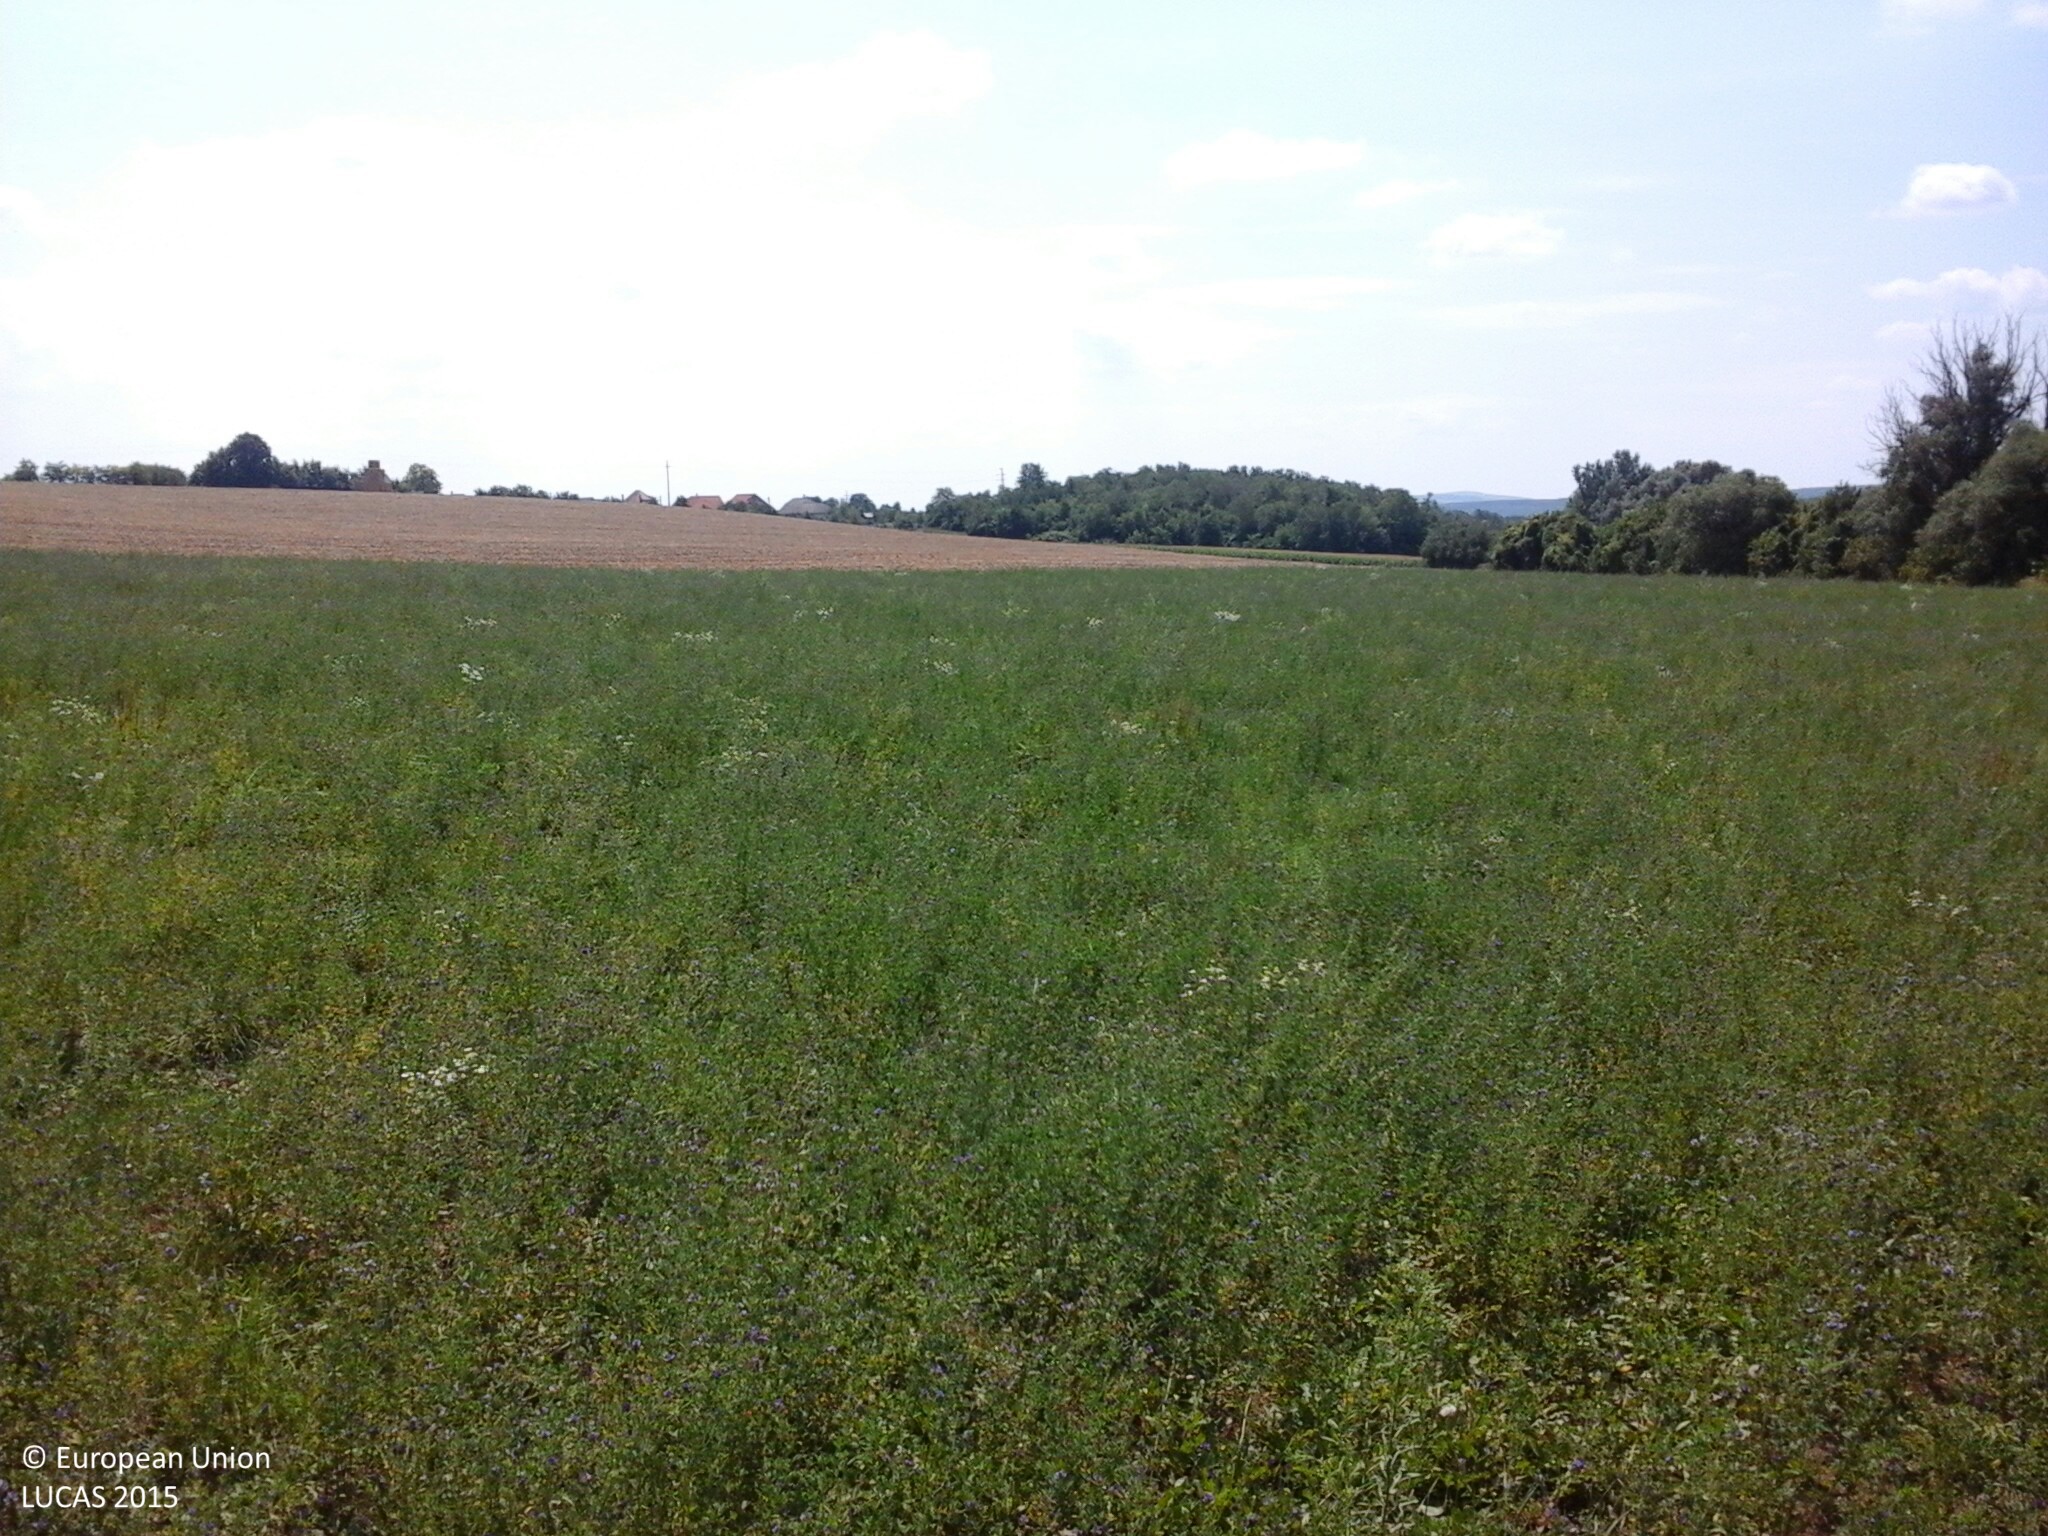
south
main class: Cropland
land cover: Lucerne
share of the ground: > 75 %
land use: Agriculture (excluding fallow land and kitchen gardens)
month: August
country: HU
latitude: 47.3525
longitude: 18.2593
